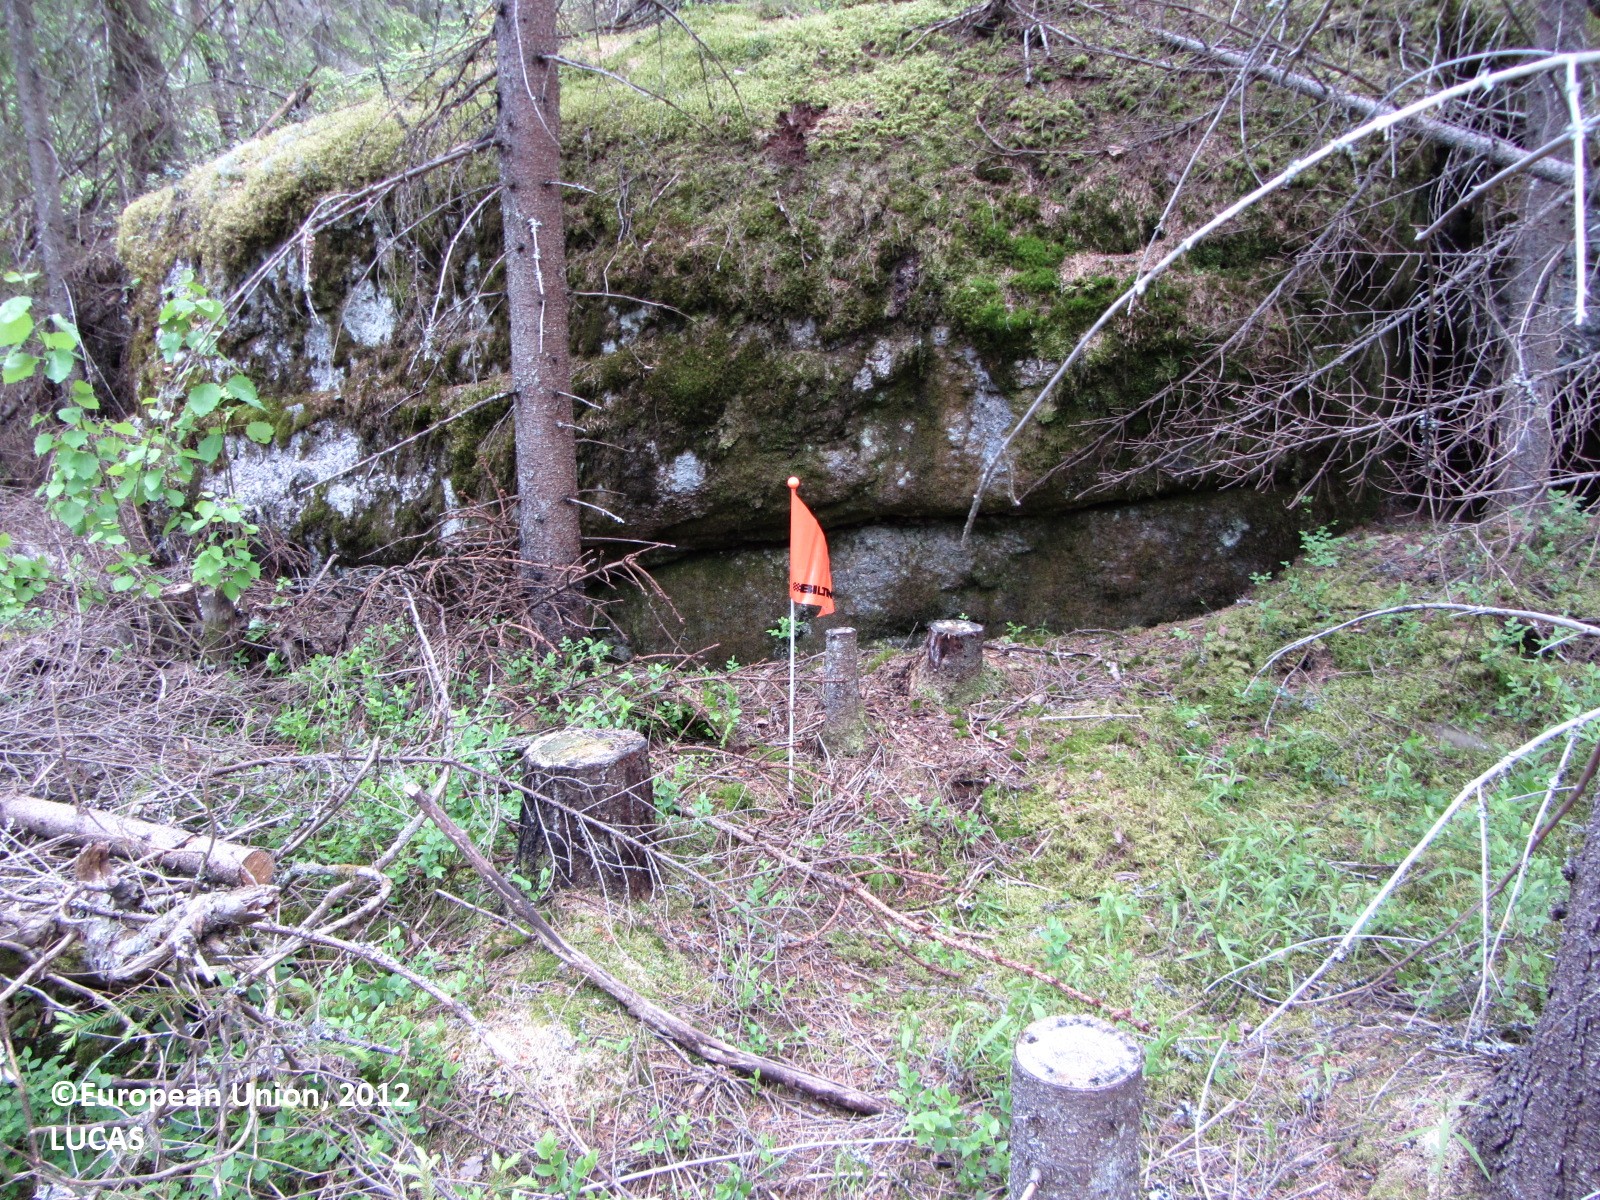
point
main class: Woodland
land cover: Spruce dominated coniferous woodland
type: boreal forest
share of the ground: 50 - 75 %
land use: Forestry
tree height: > 5 m
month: June
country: FI
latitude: 61.8761
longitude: 24.6072
